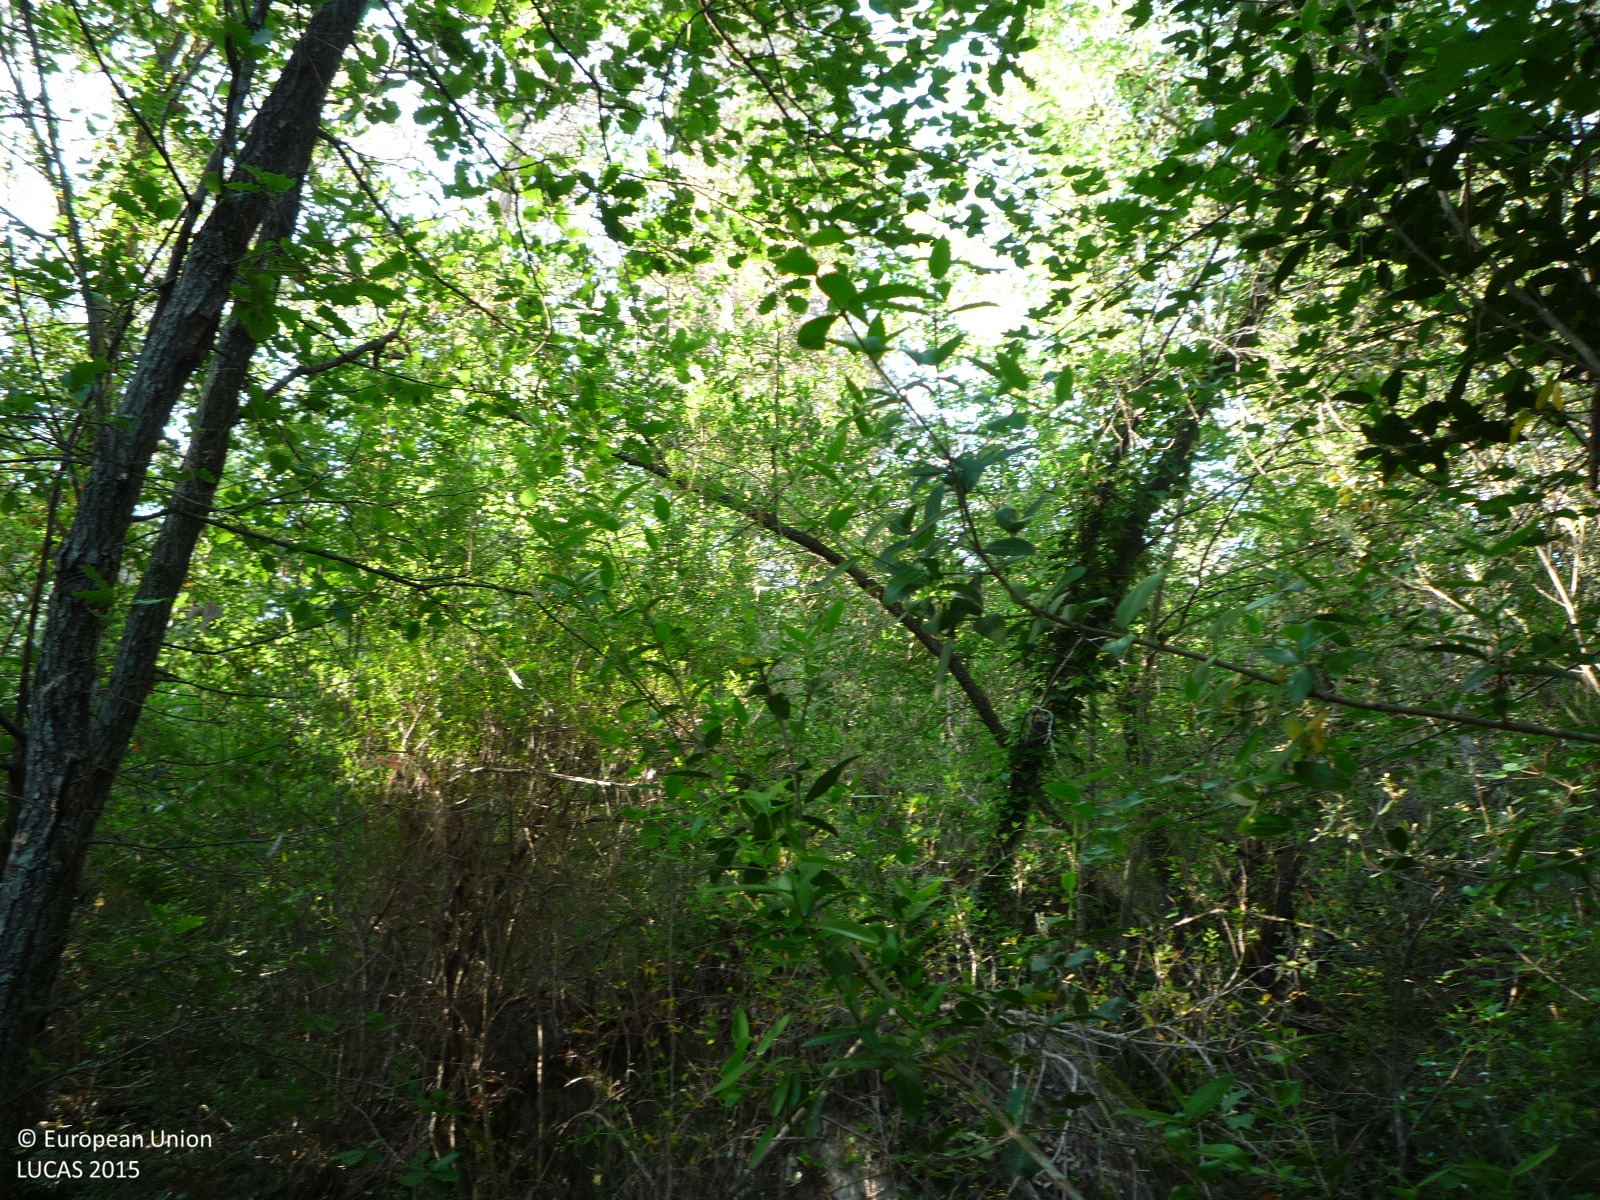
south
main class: Woodland
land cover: Other mixed woodland
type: coniferous forest of the mediterranean region
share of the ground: > 75 %
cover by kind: coniferous forest trees 55 %, broadleaved forest trees 45 %
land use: Semi-natural and natural areas not in use
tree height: > 5 m
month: May
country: ES
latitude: 41.8384
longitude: 1.6687
